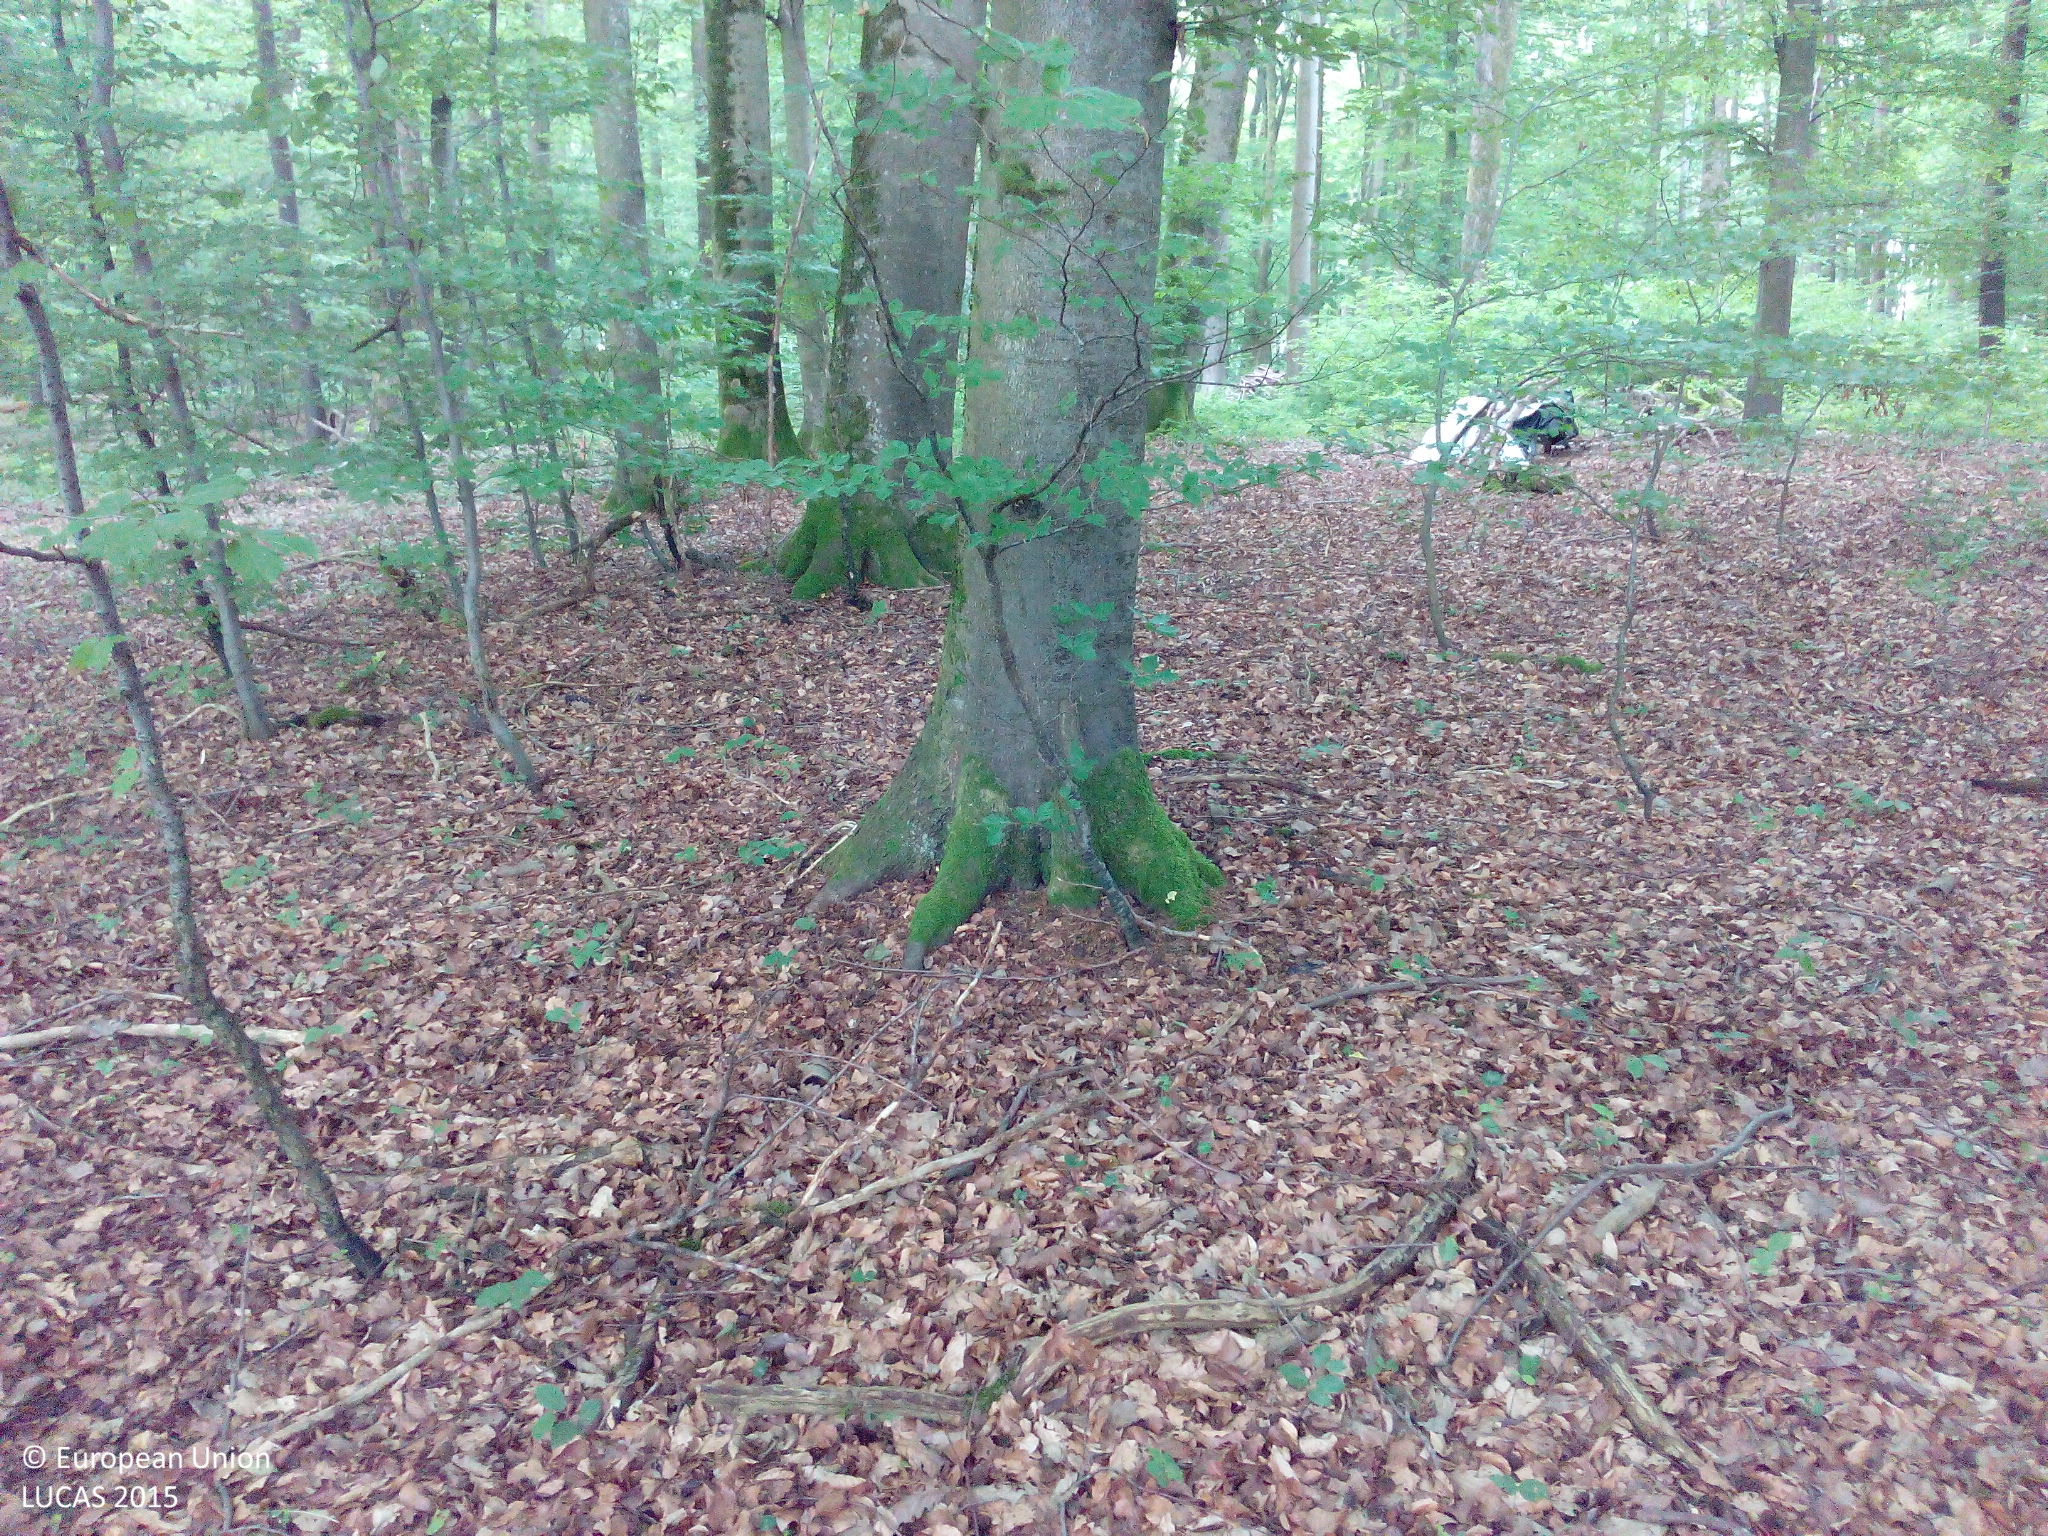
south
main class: Woodland
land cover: Broadleaved woodland
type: mesophytic deciduous forest
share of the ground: > 75 %
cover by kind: broadleaved forest trees 100 %
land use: Forestry
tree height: > 5 m
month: June
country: DE
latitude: 48.7269
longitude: 9.6875
